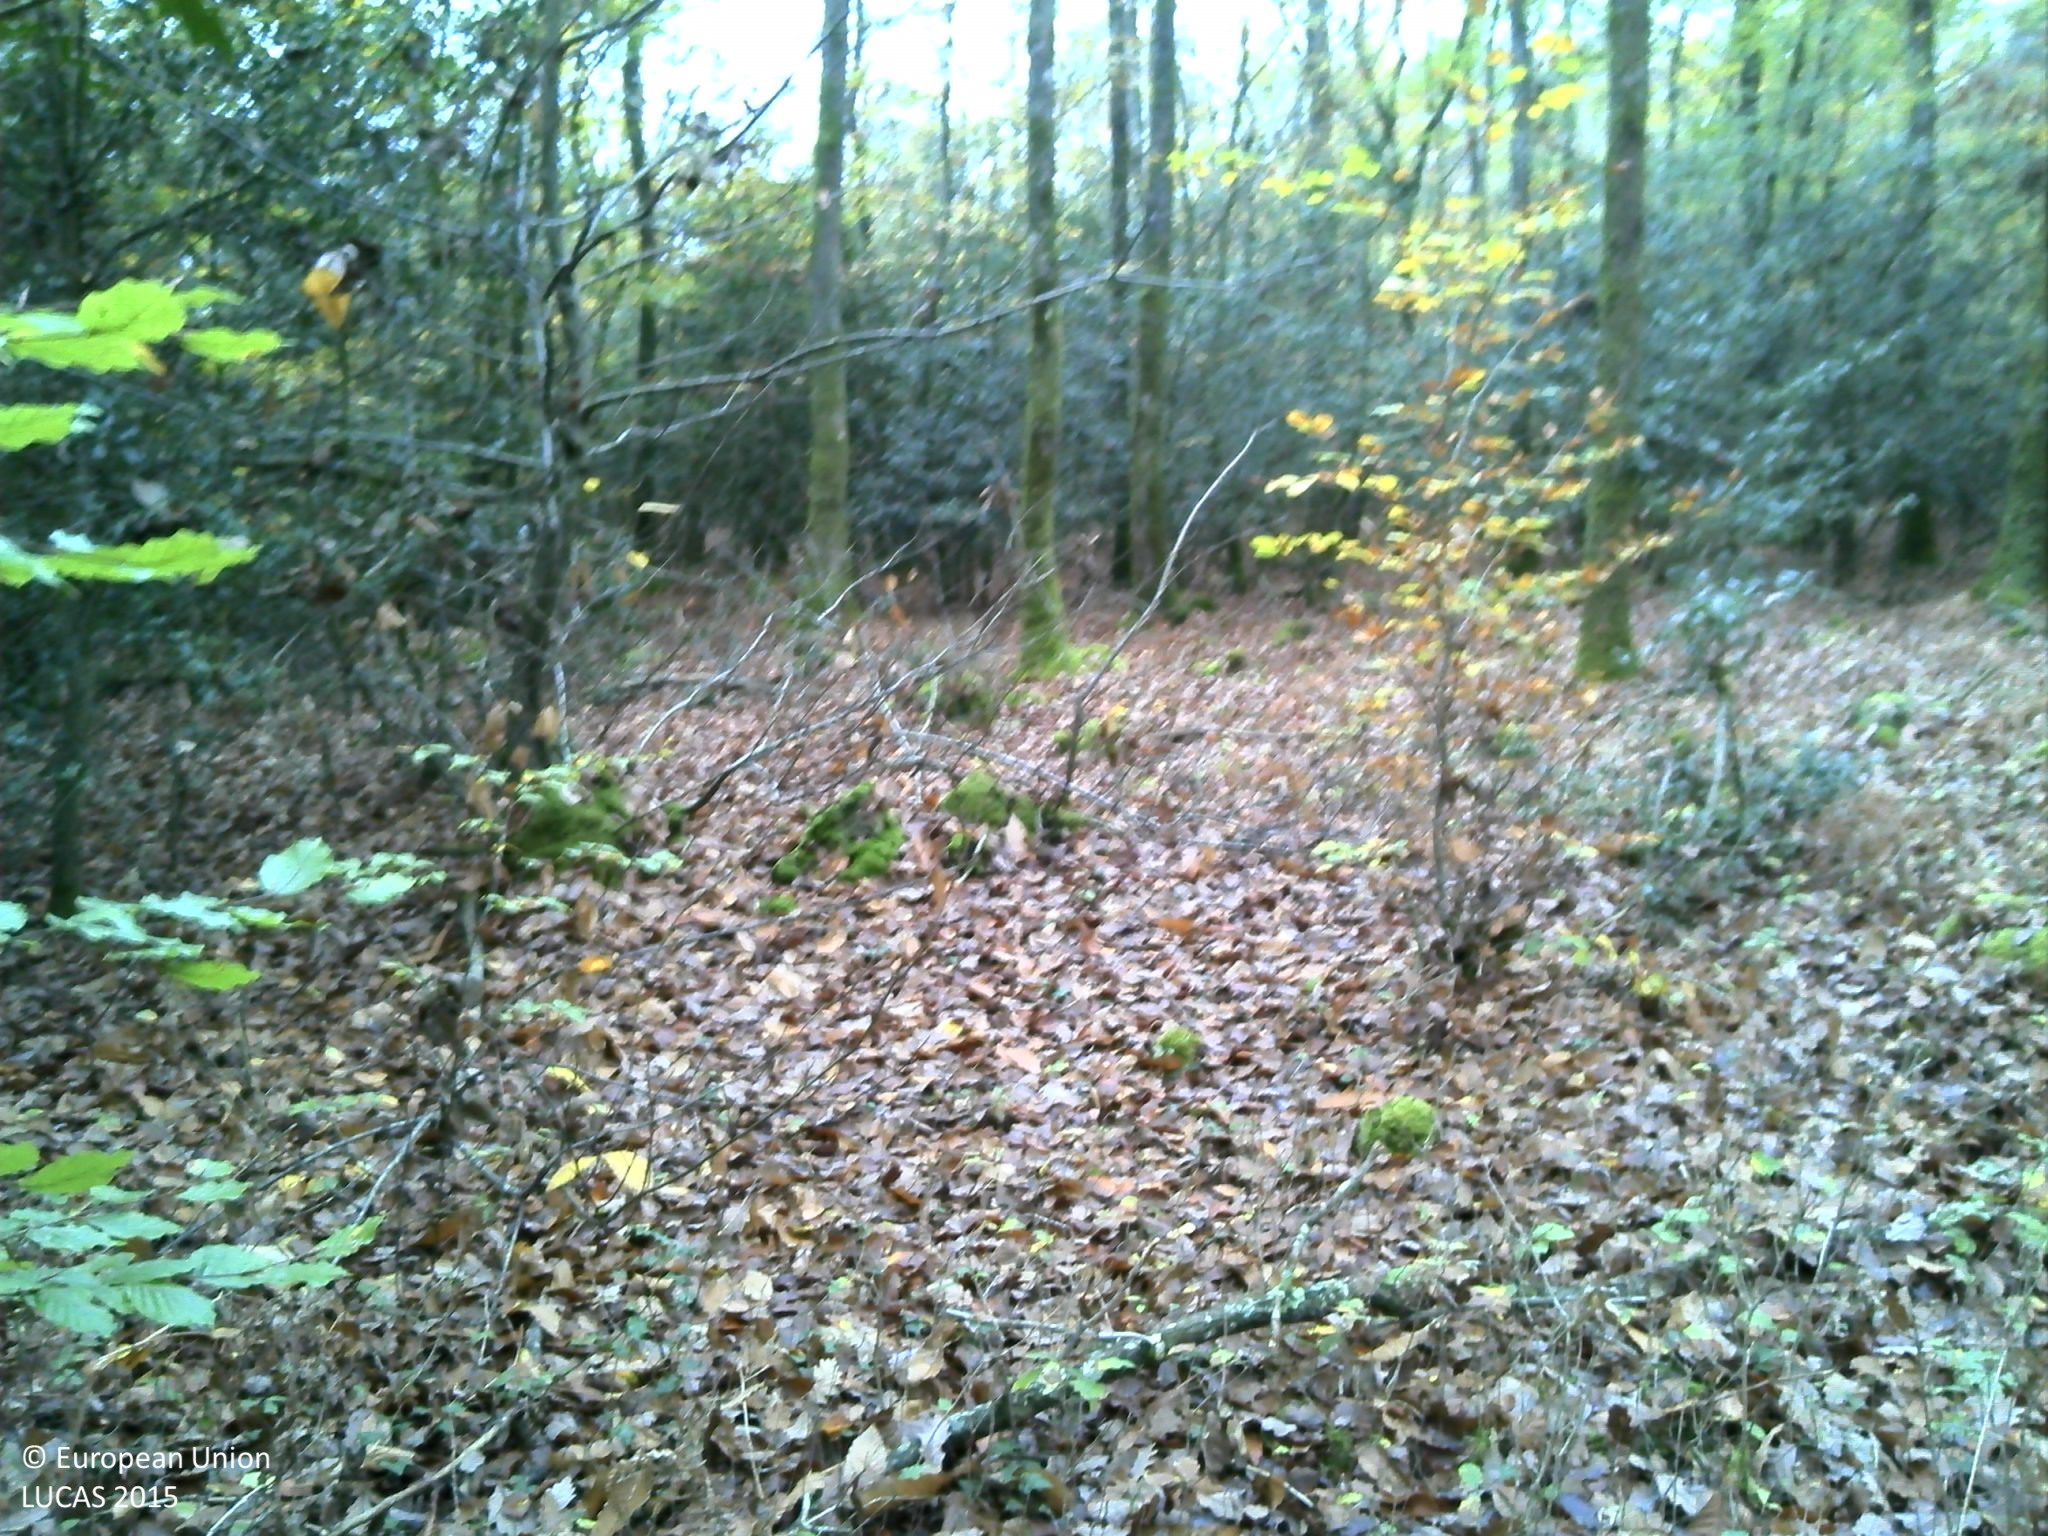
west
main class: Woodland
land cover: Broadleaved woodland
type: acidophilous oak and oak-birch forest
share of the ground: > 75 %
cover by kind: broadleaved forest trees 85 %, herbaceous plants 10 %, lichens and mosses 5 %
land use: Forestry
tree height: > 5 m
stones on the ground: < 10 %
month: November
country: FR
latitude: 47.5474
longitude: -1.3215
